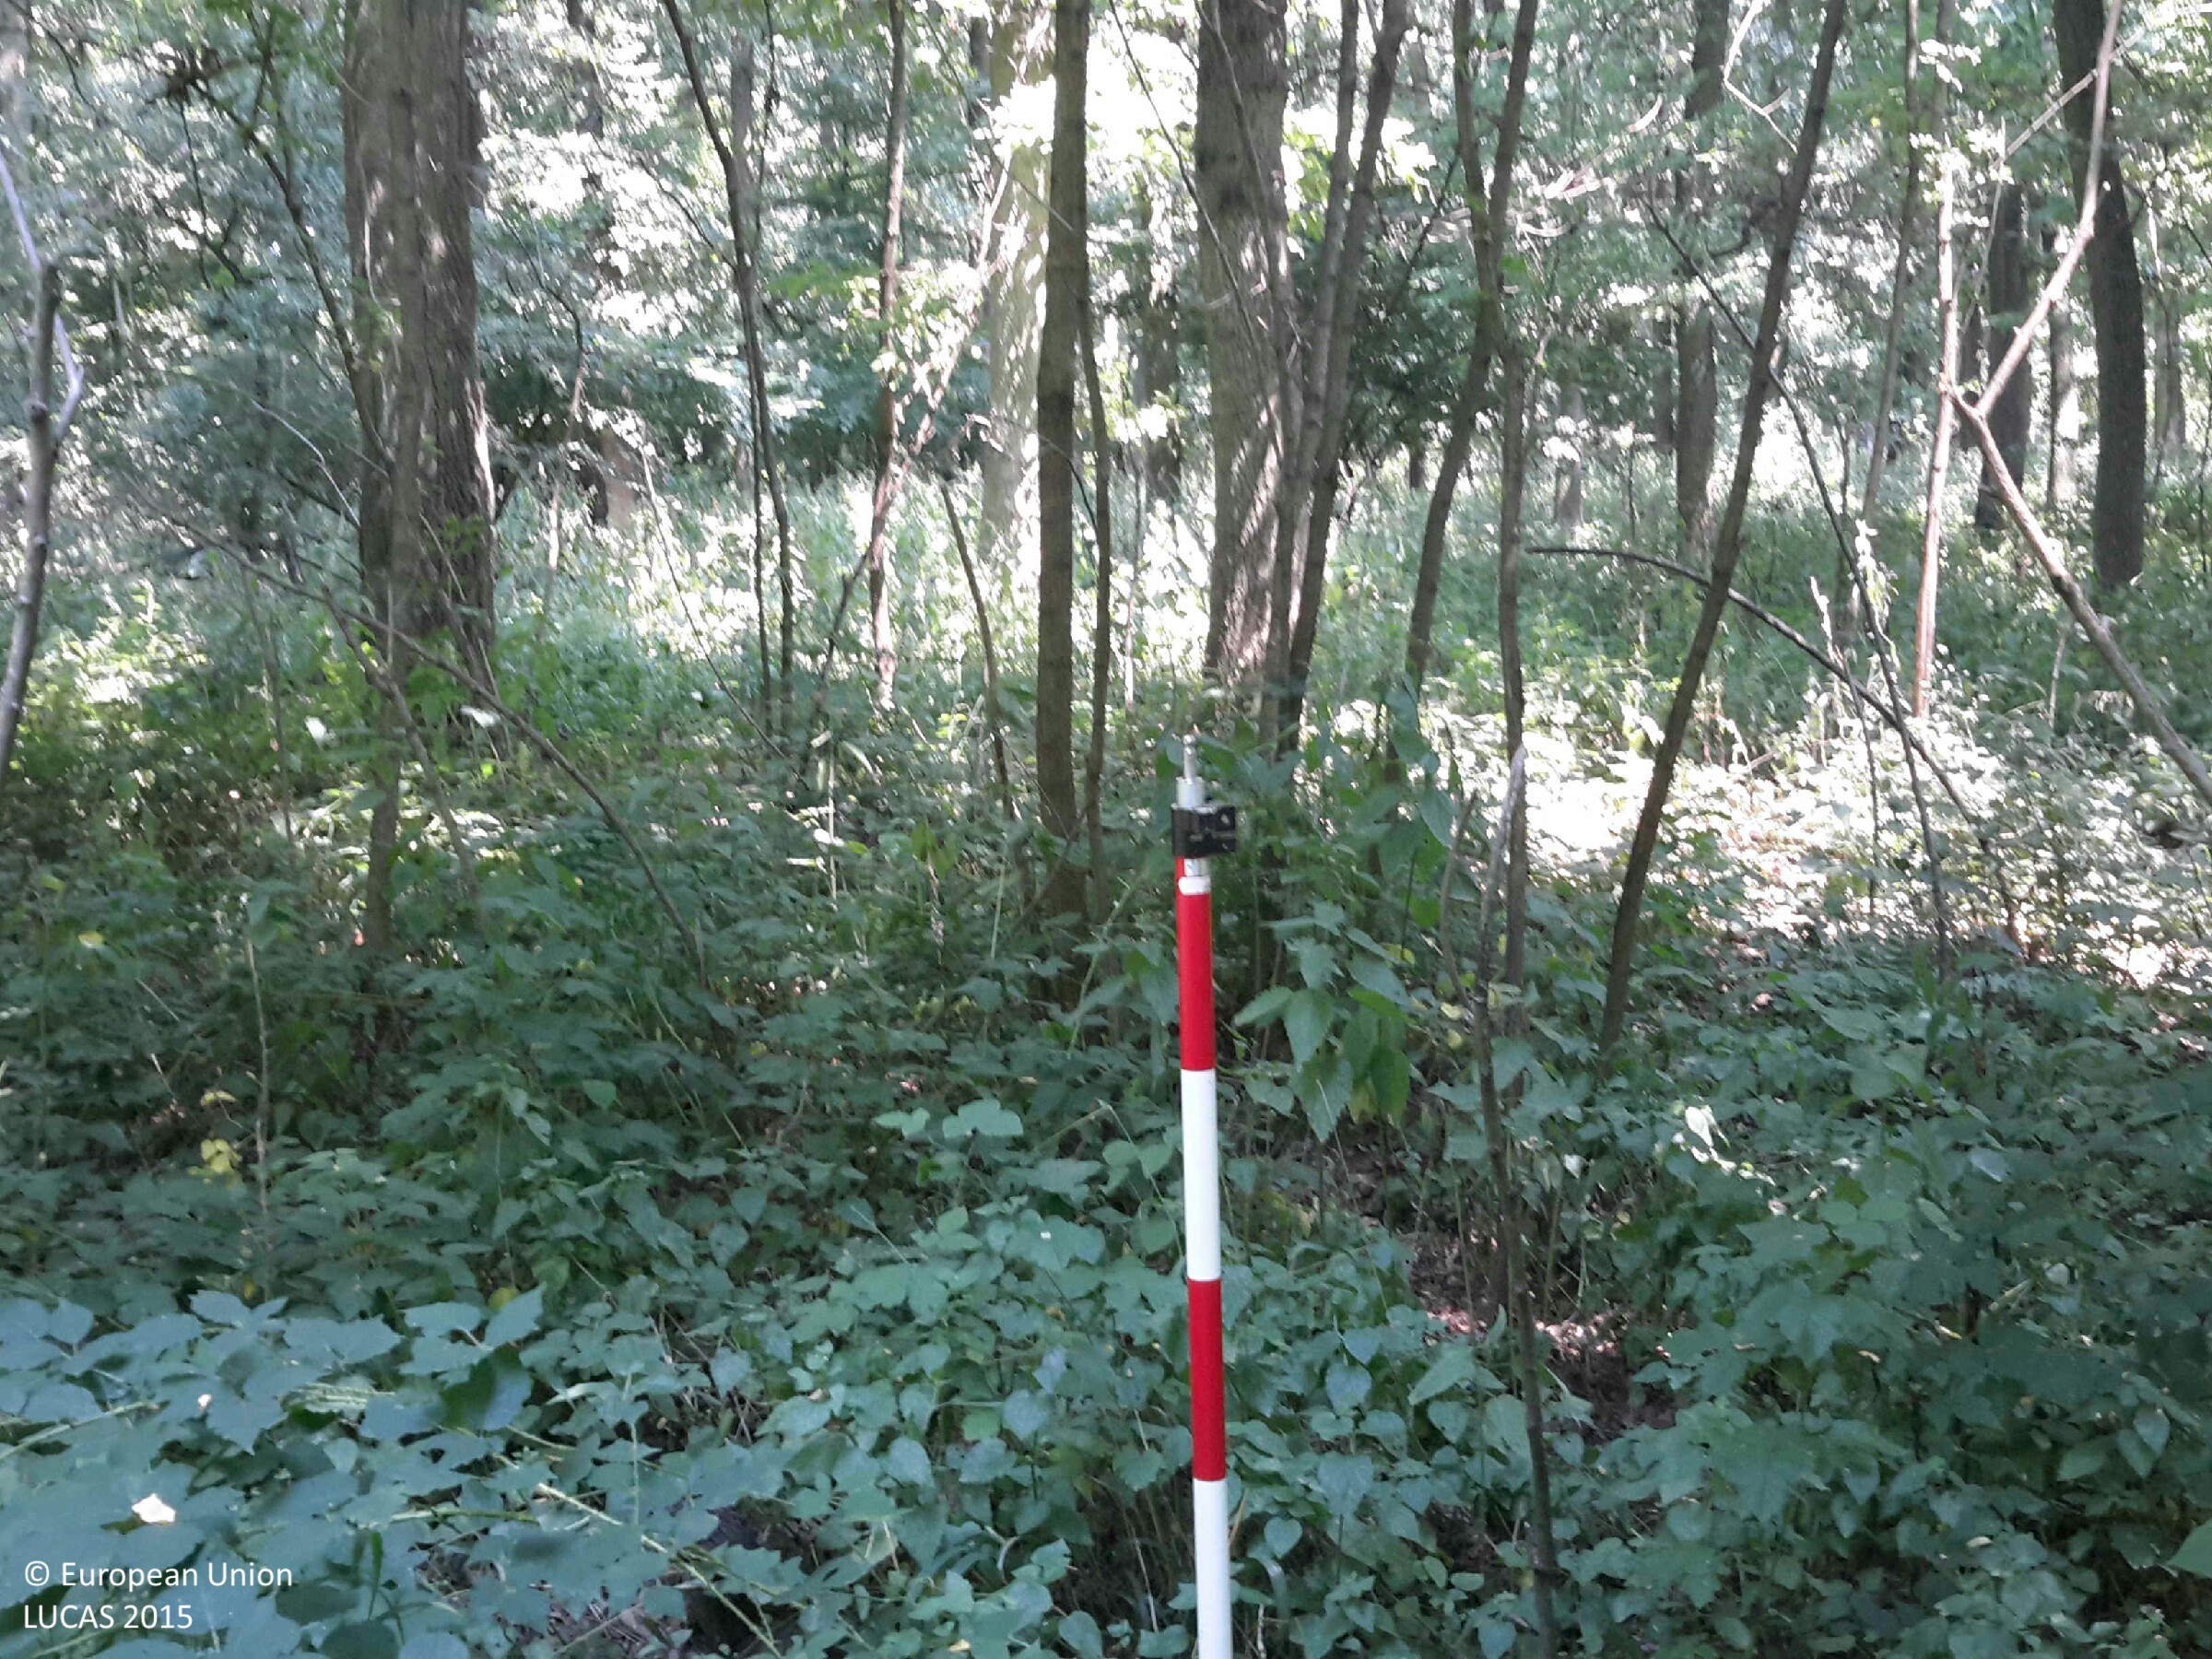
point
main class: Woodland
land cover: Broadleaved woodland
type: mesophytic deciduous forest
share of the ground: > 75 %
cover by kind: broadleaved forest trees 80 %, shrubs 10 %, herbaceous plants 10 %
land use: Forestry
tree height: > 5 m
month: July
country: HU
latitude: 47.1583
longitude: 16.6115
